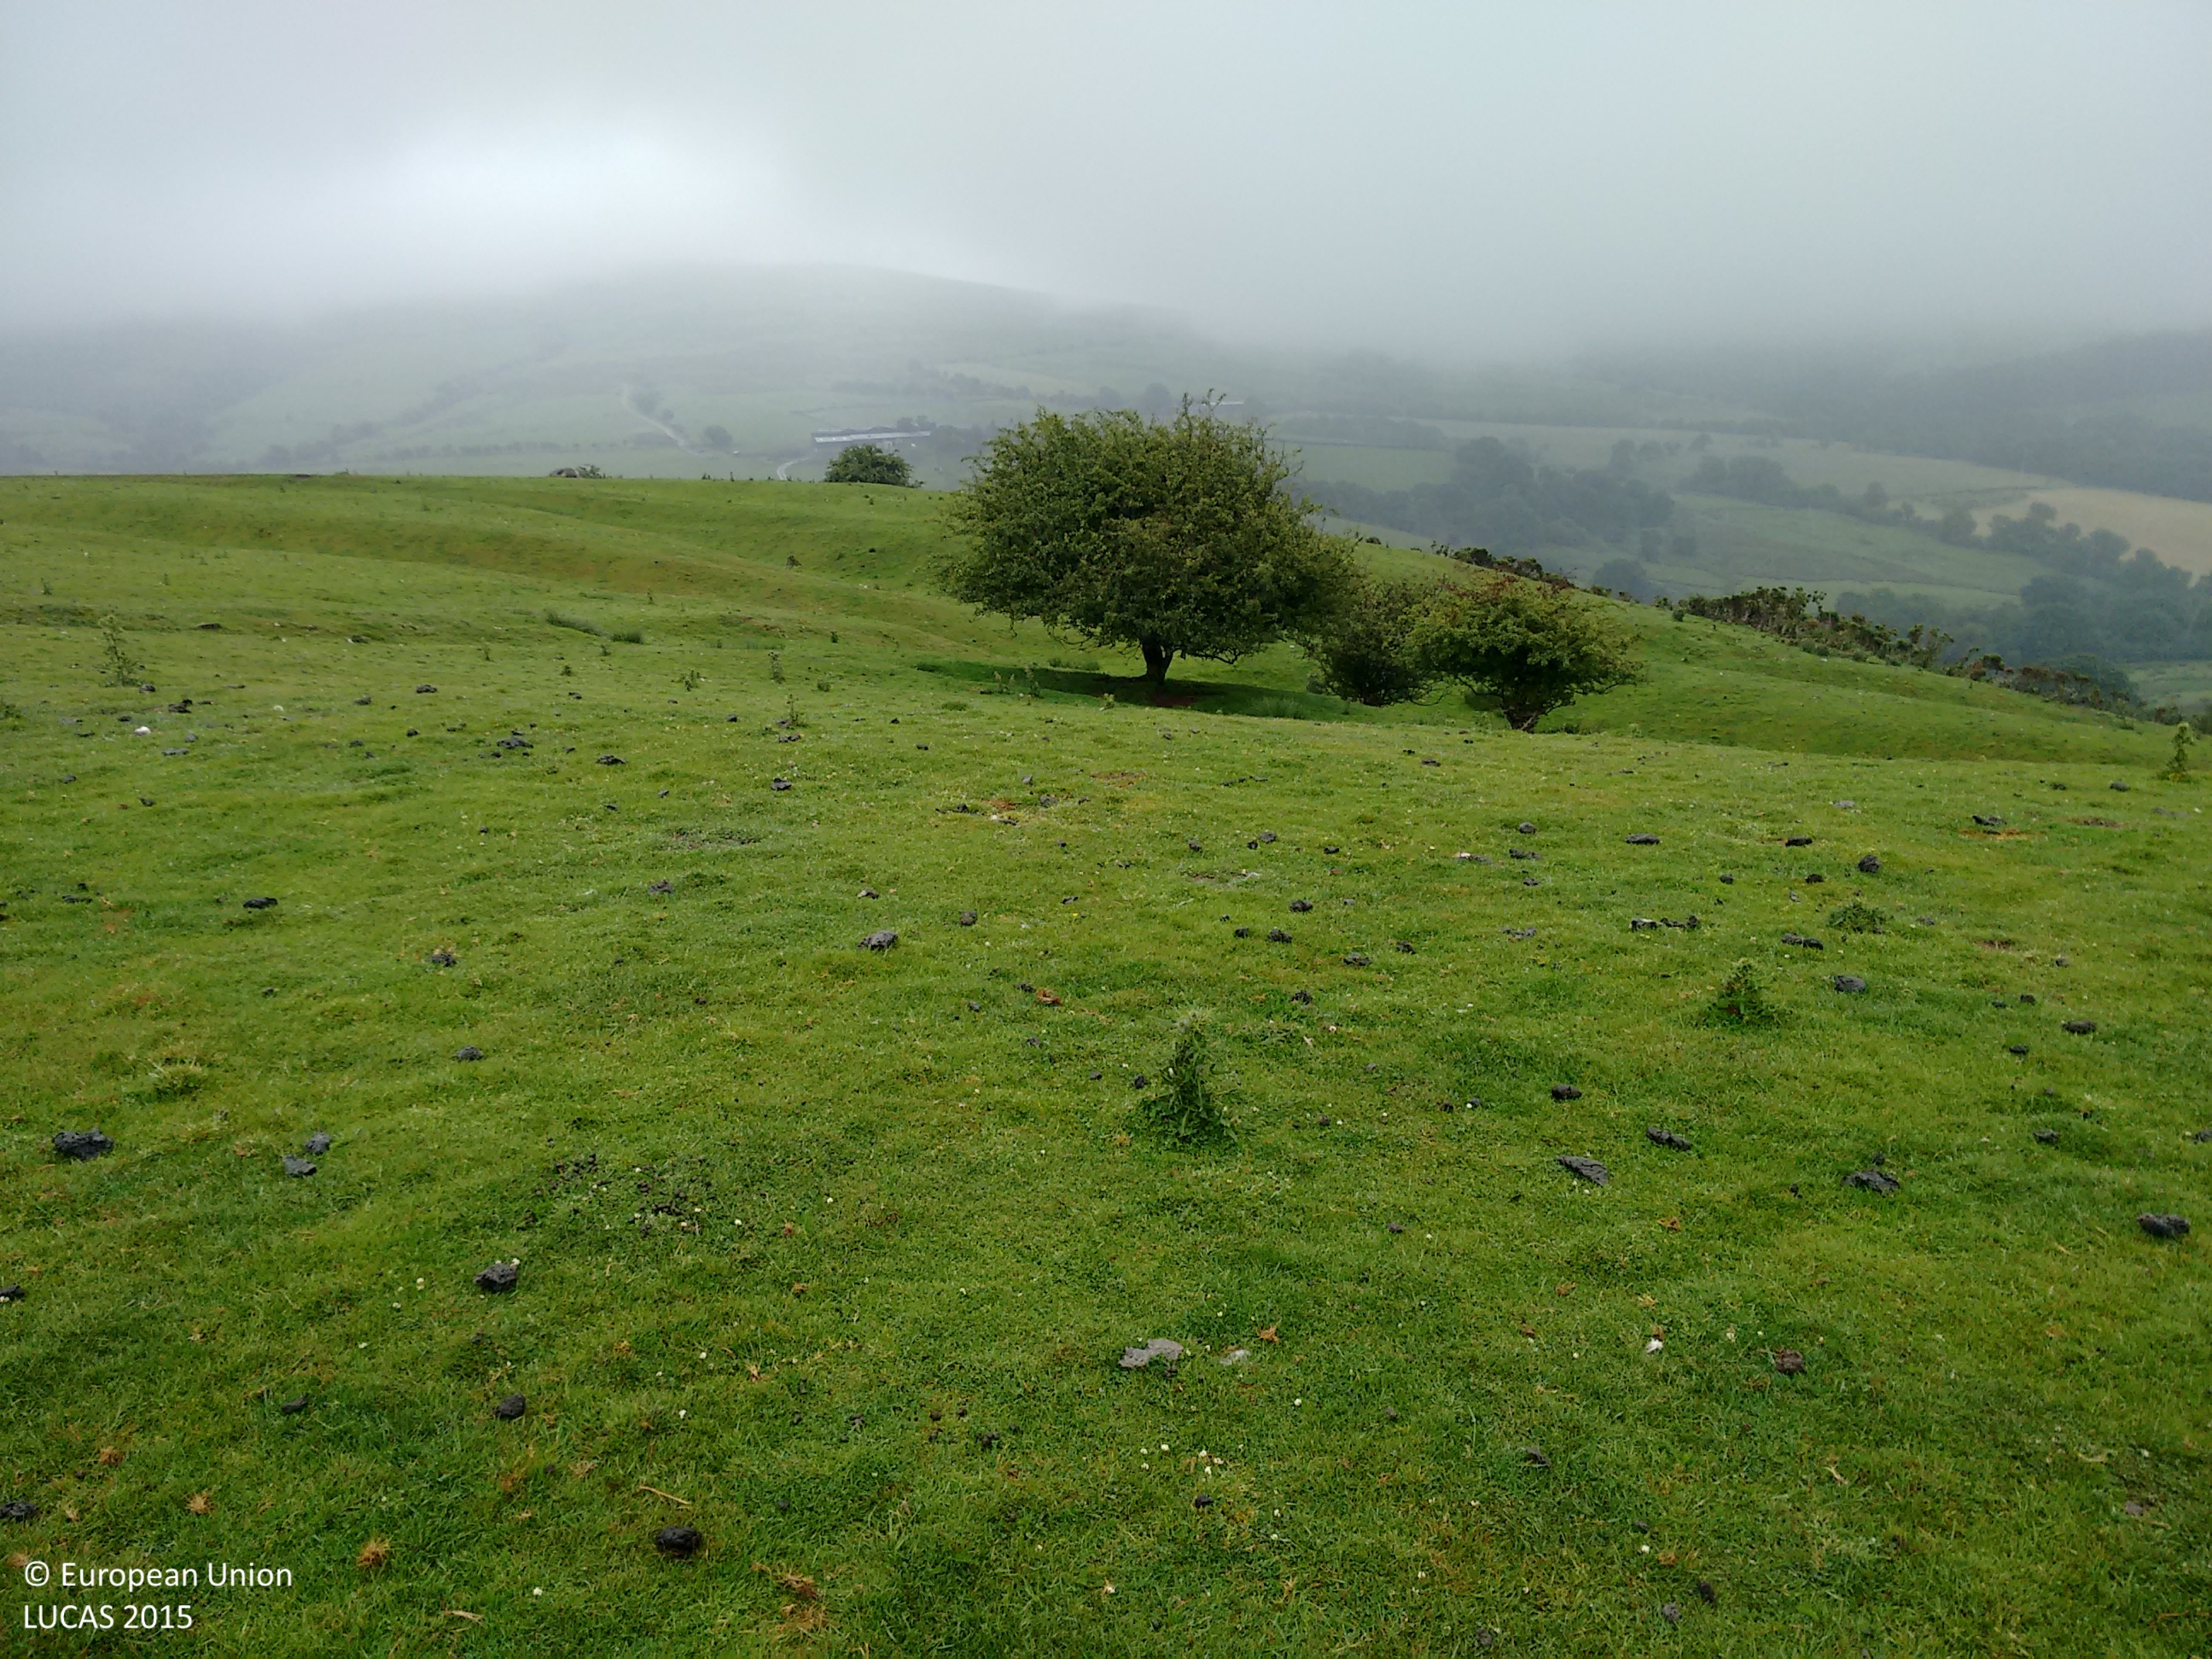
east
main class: Grassland
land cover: Grassland without tree/shrub cover
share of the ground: > 75 %
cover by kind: herbaceous plants 100 %
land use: Agriculture (excluding fallow land and kitchen gardens)
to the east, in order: Grassland without tree/shrub cover; Grassland with sparse tree/shrub cover; Shrubland without tree cover; Grassland with sparse tree/shrub cover; Dry stone walls; Grassland without tree/shrub cover
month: July
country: GB
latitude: 53.1506
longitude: -1.9748
